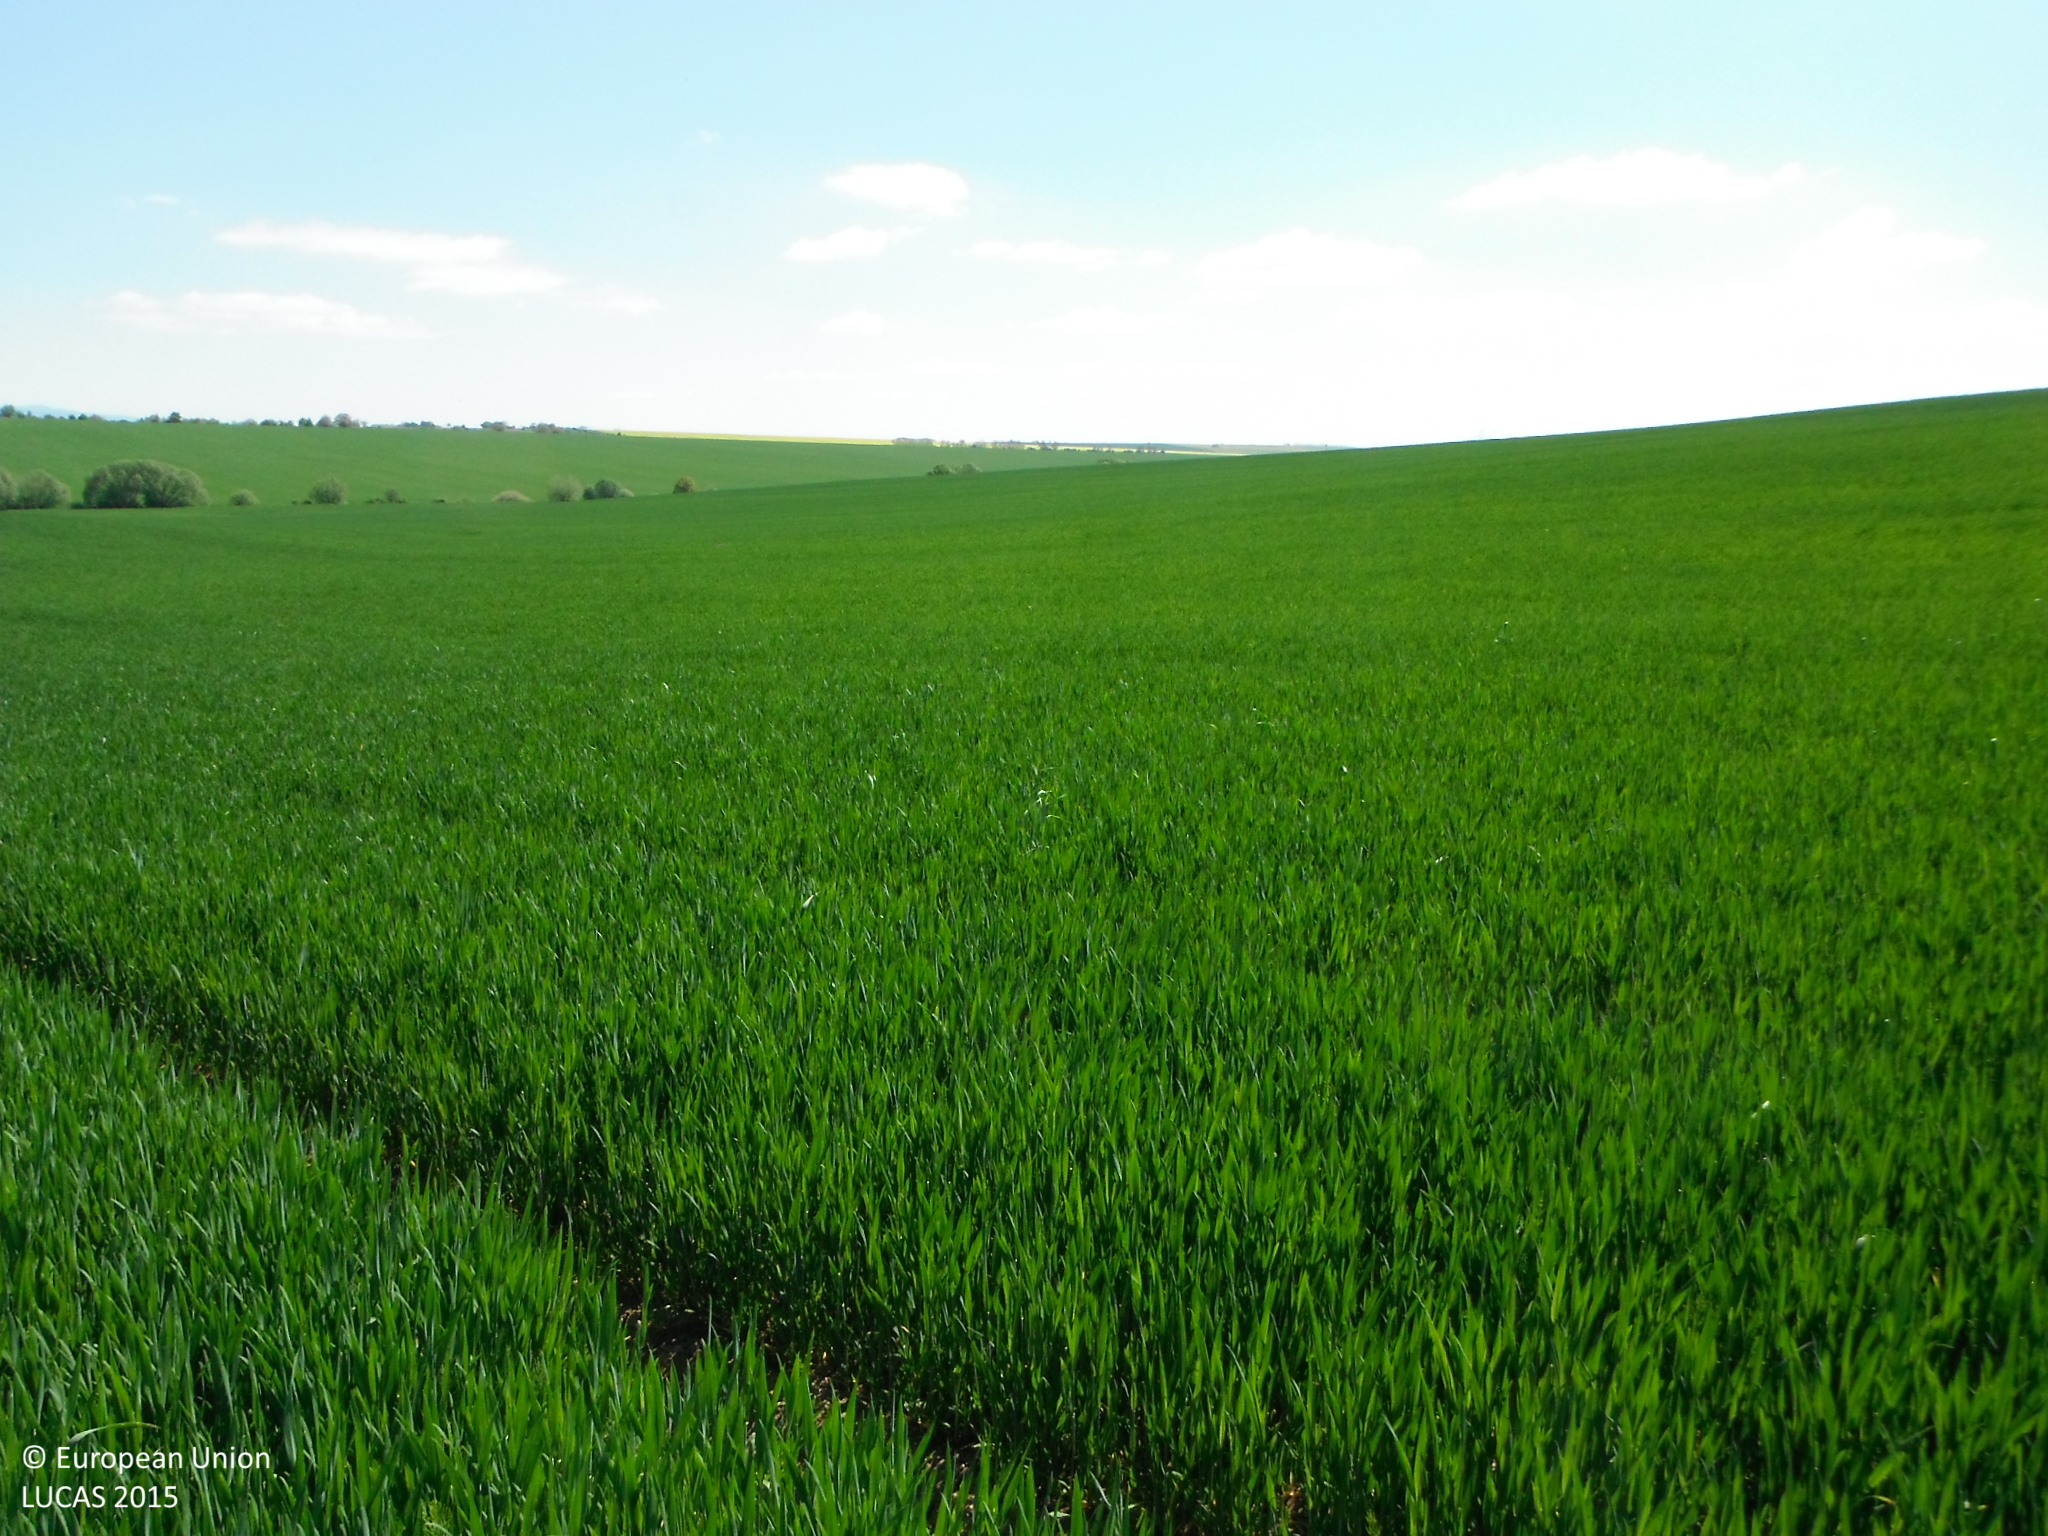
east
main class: Cropland
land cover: Common wheat
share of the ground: > 75 %
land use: Agriculture (excluding fallow land and kitchen gardens)
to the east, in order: Common wheat
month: May
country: SK
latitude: 48.3136
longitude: 18.2265
